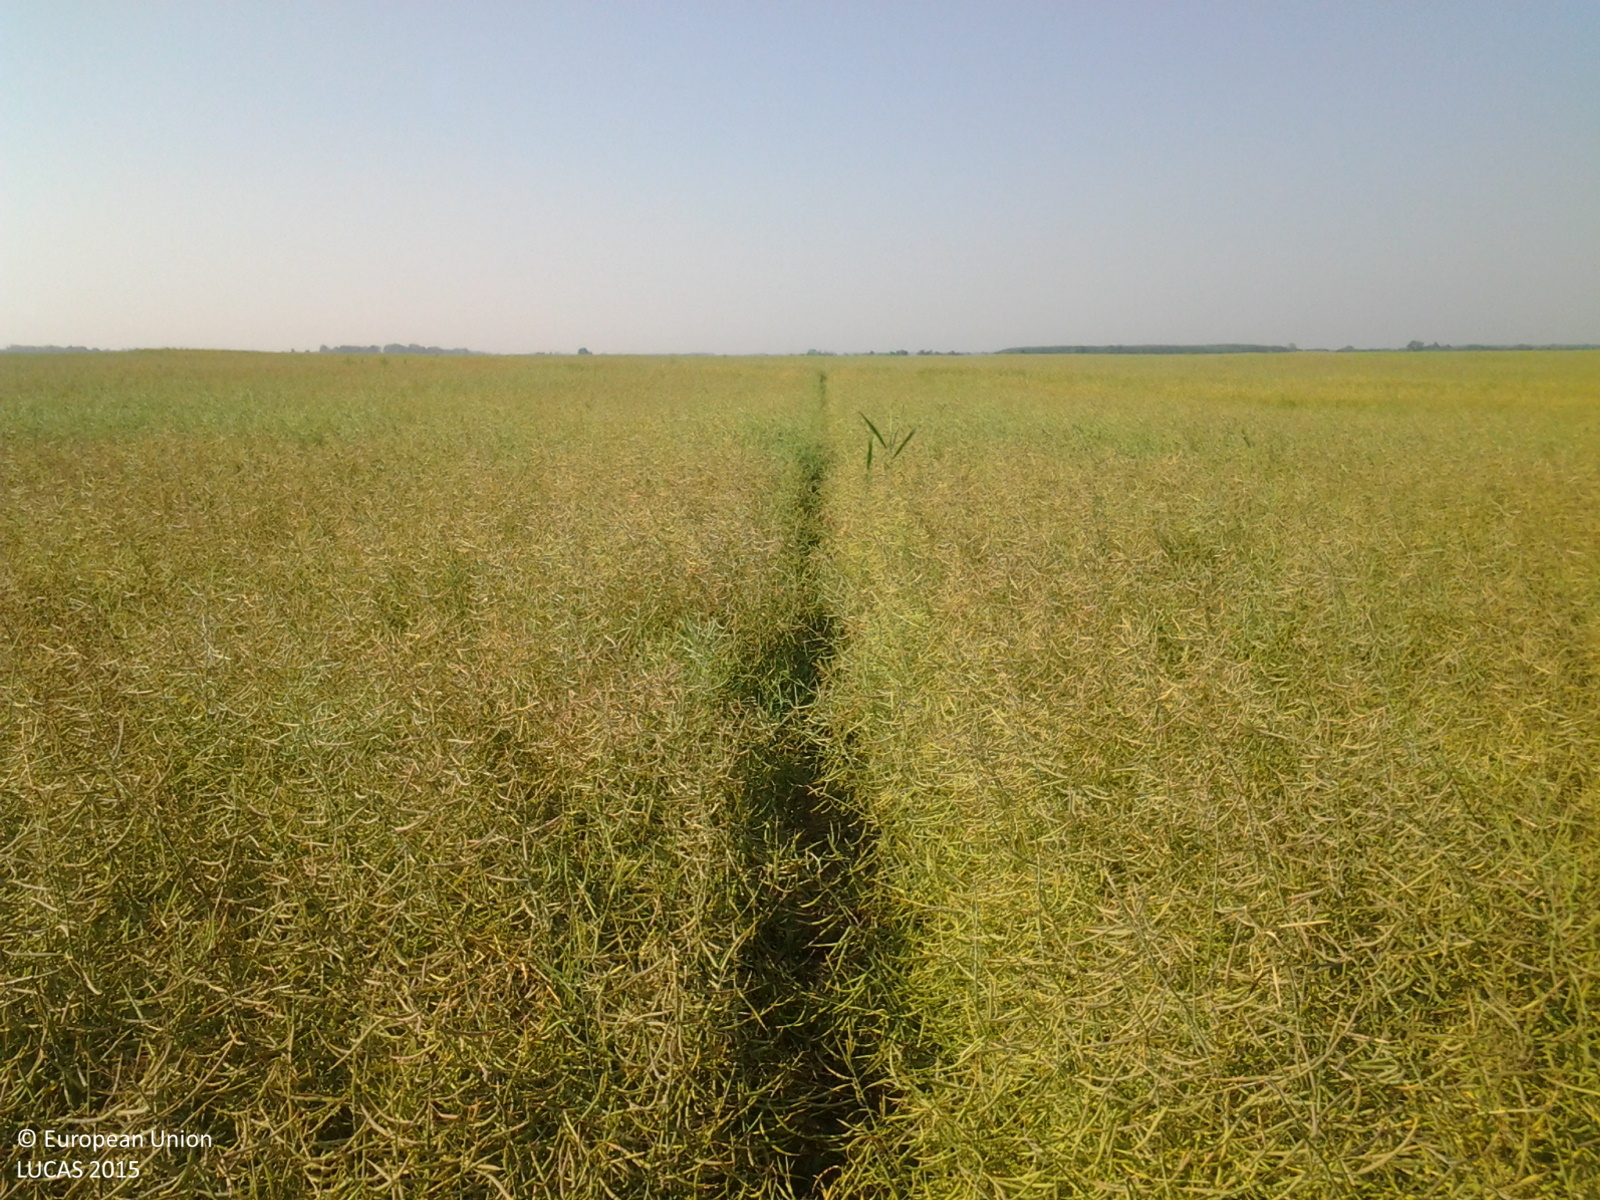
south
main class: Cropland
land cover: Rape and turnip rape
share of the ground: > 75 %
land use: Agriculture (excluding fallow land and kitchen gardens)
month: June
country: HU
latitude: 46.5931
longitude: 18.9284
